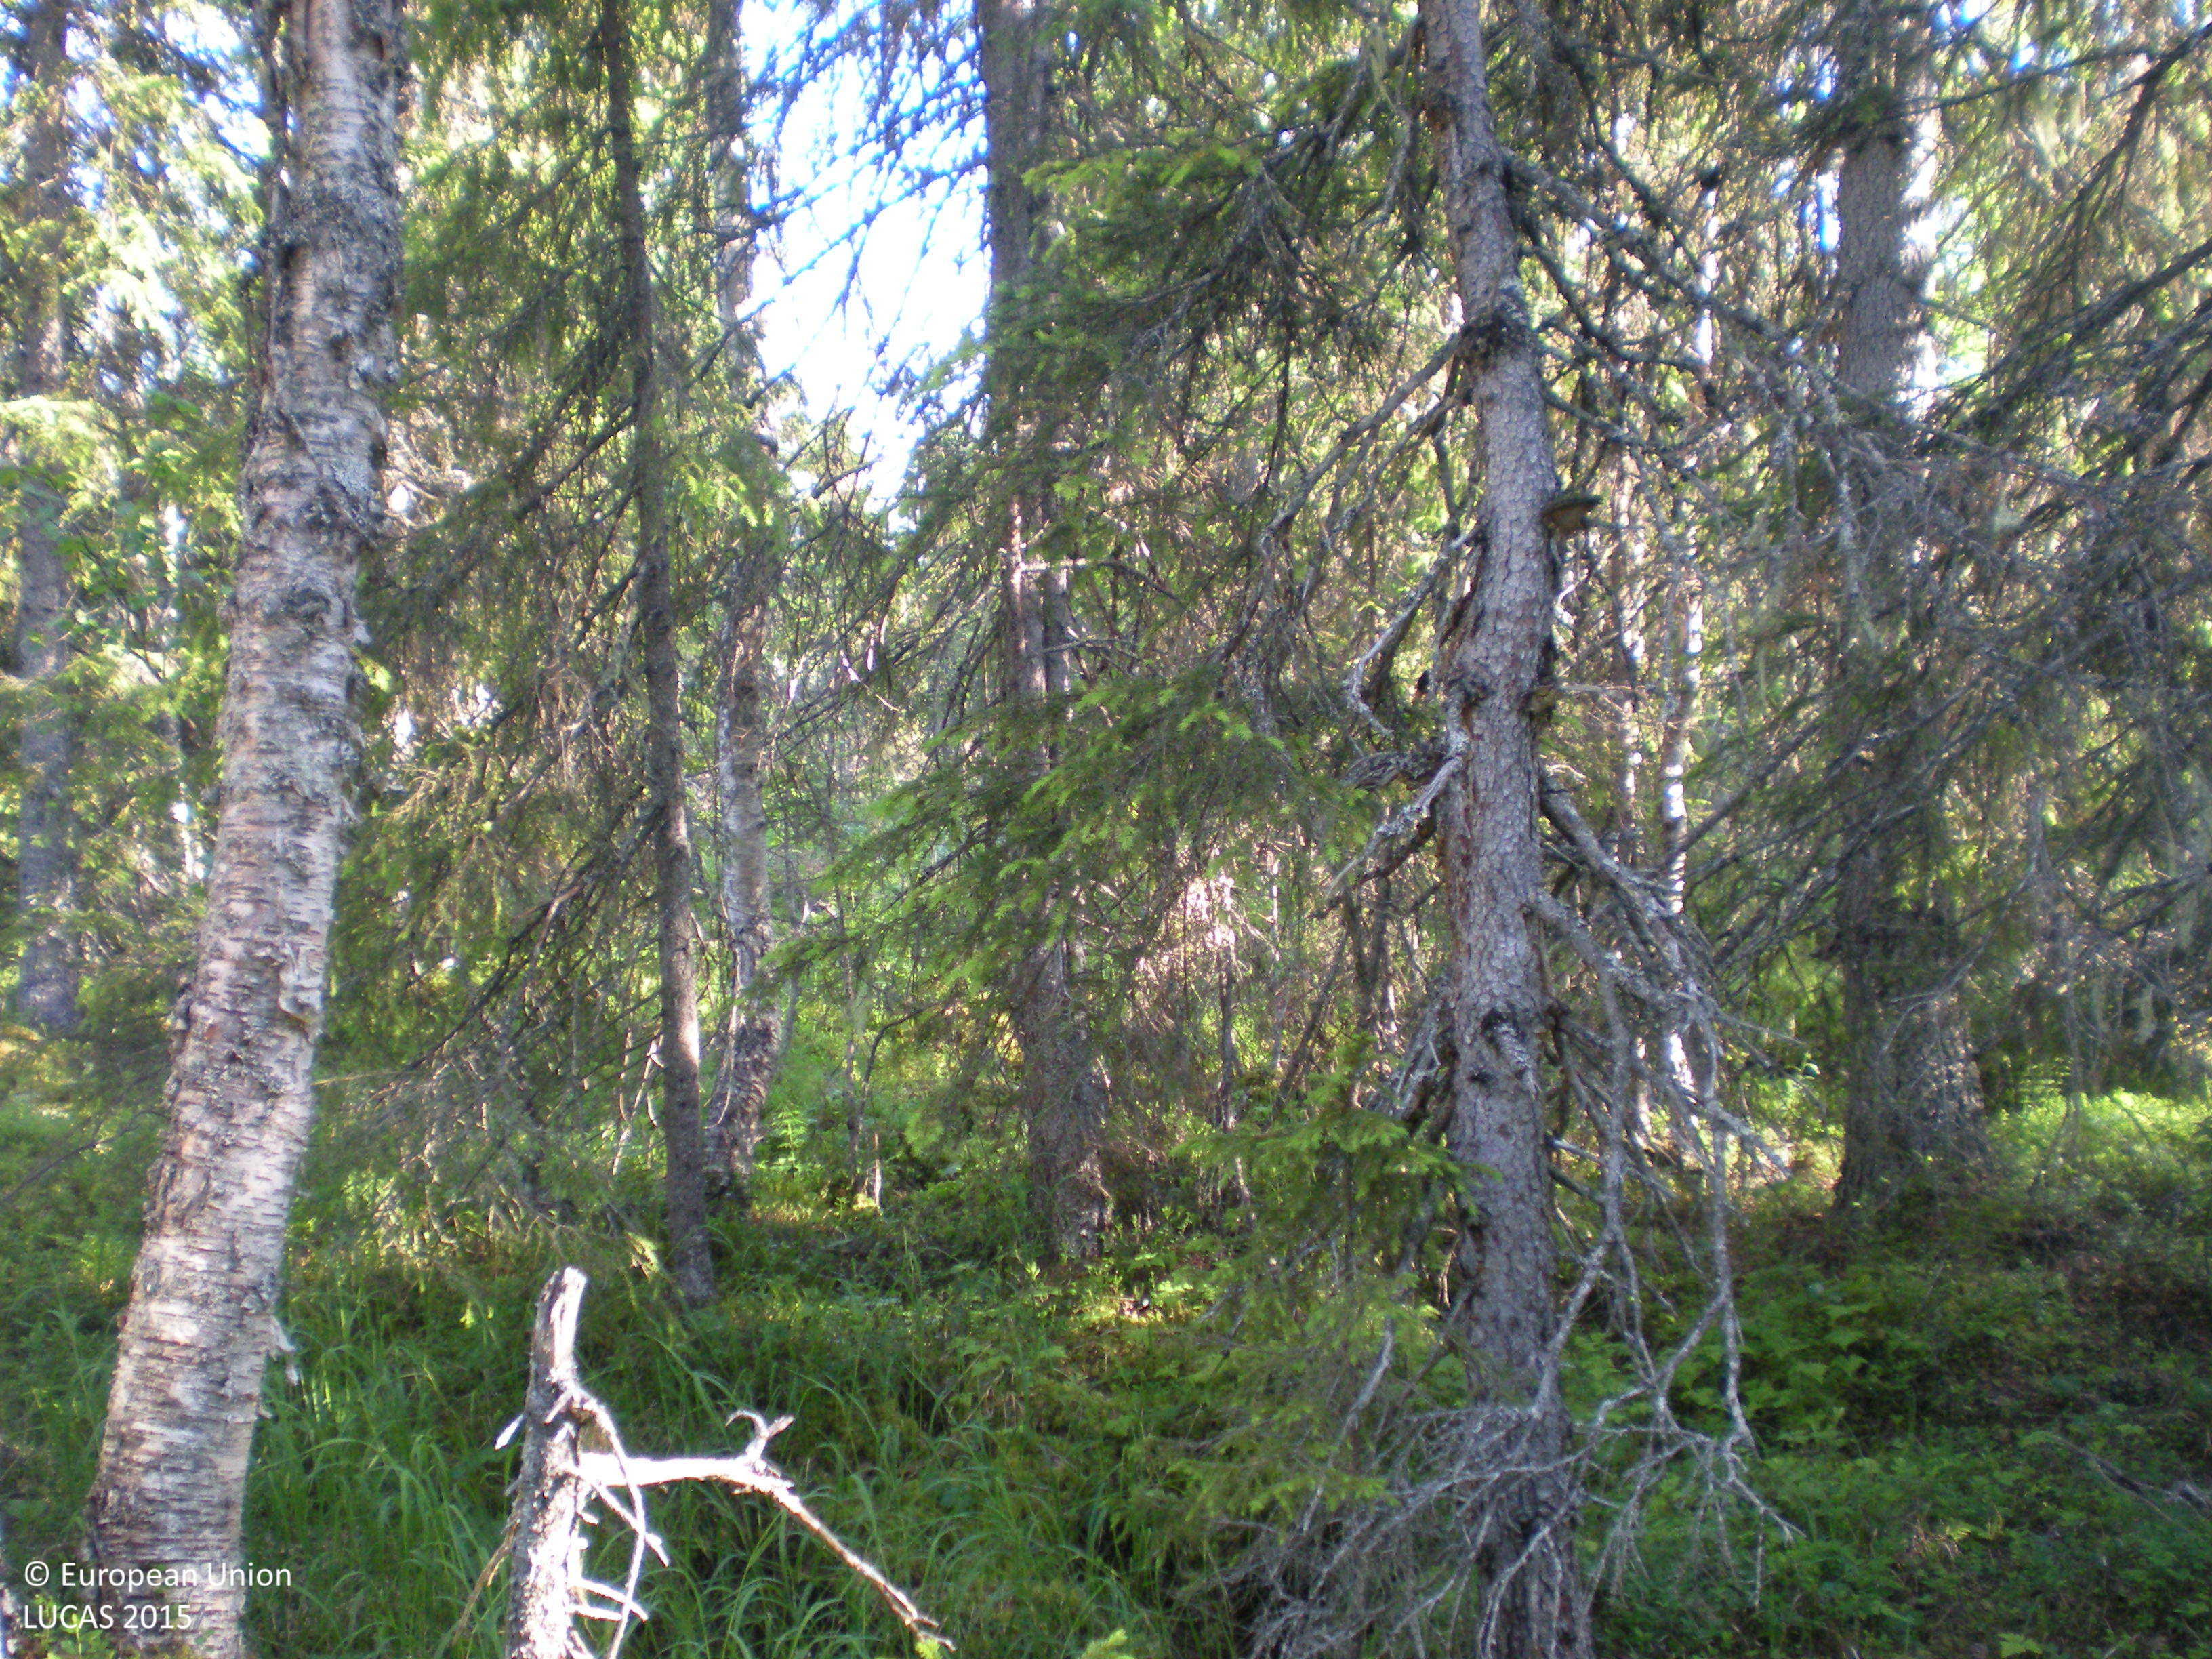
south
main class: Woodland
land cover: Spruce dominated mixed woodland
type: boreal forest
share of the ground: > 75 %
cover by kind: coniferous forest trees 50 %, broadleaved forest trees 25 %, shrubs 20 %, lichens and mosses 5 %
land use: Forestry
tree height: > 5 m
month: July
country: SE
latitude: 65.6061
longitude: 16.9686
